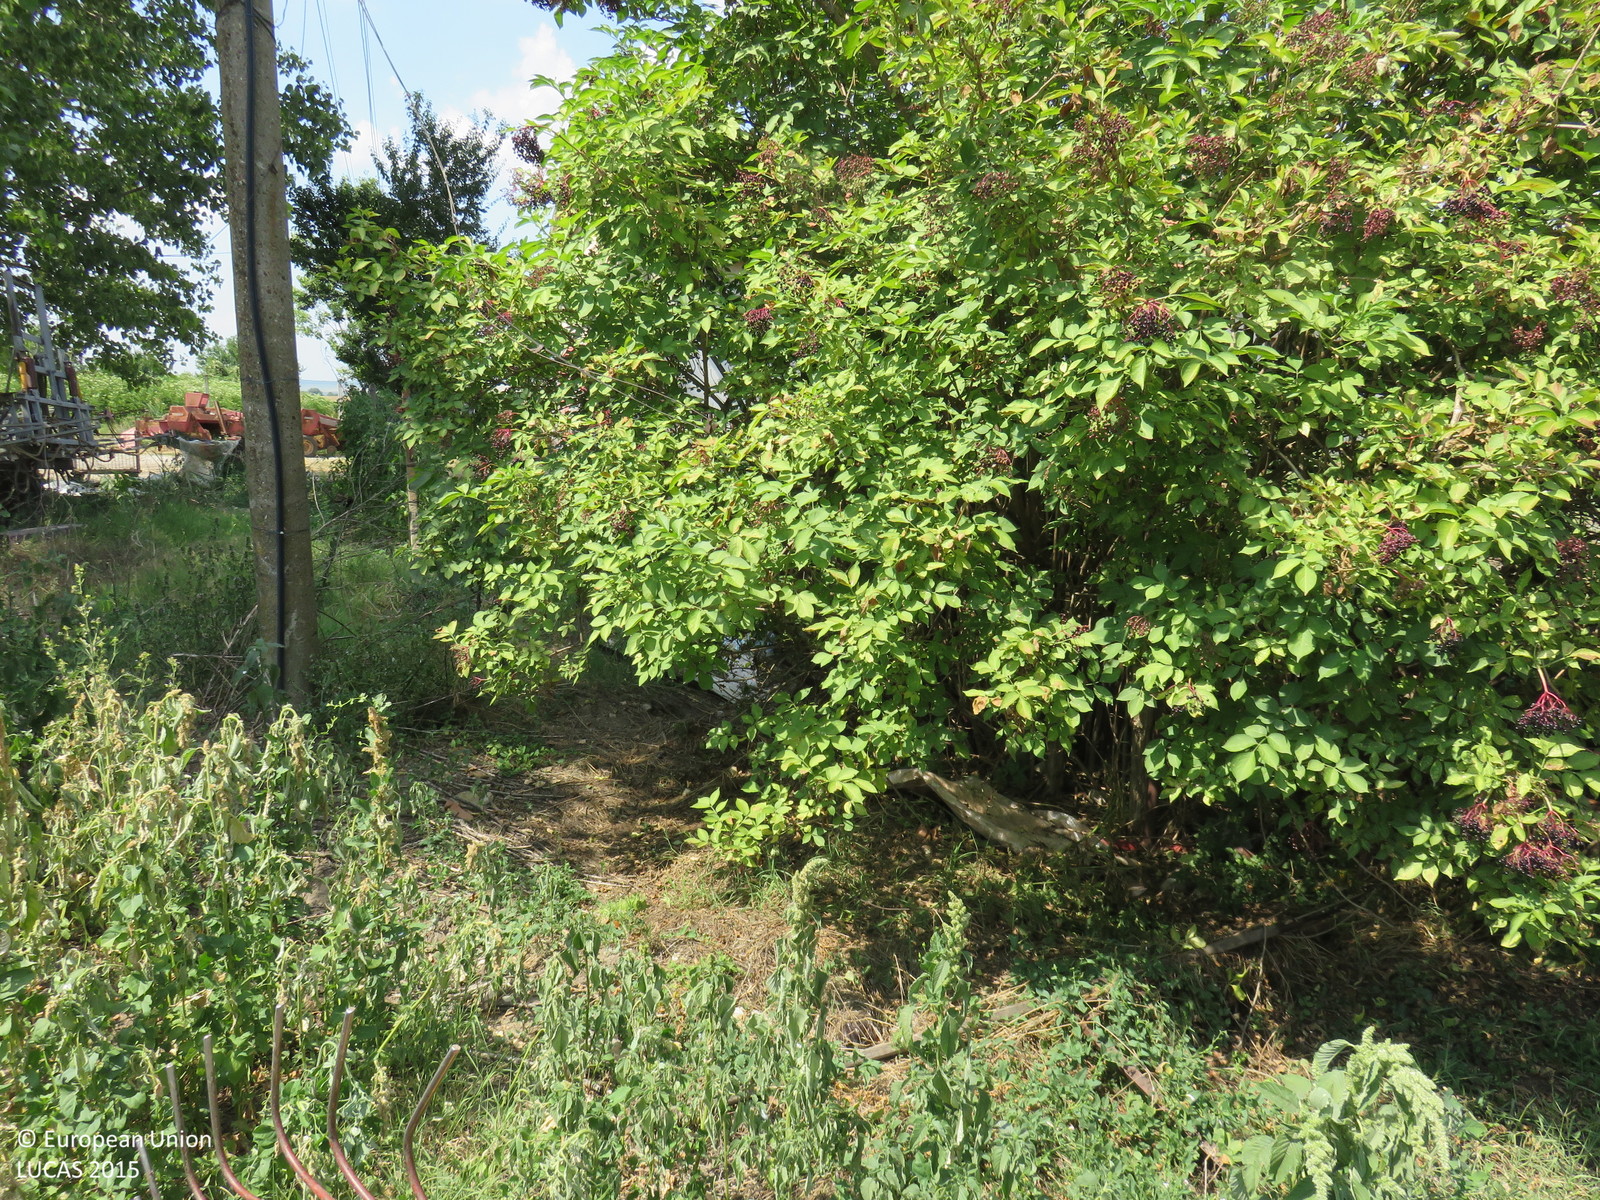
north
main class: Grassland
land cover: Spontaneously vegetated surfaces
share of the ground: > 75 %
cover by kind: herbaceous plants 90 %, unconsolidated bare surface 10 %
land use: Agriculture (excluding fallow land and kitchen gardens)
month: July
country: BG
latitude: 43.4207
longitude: 25.1040
